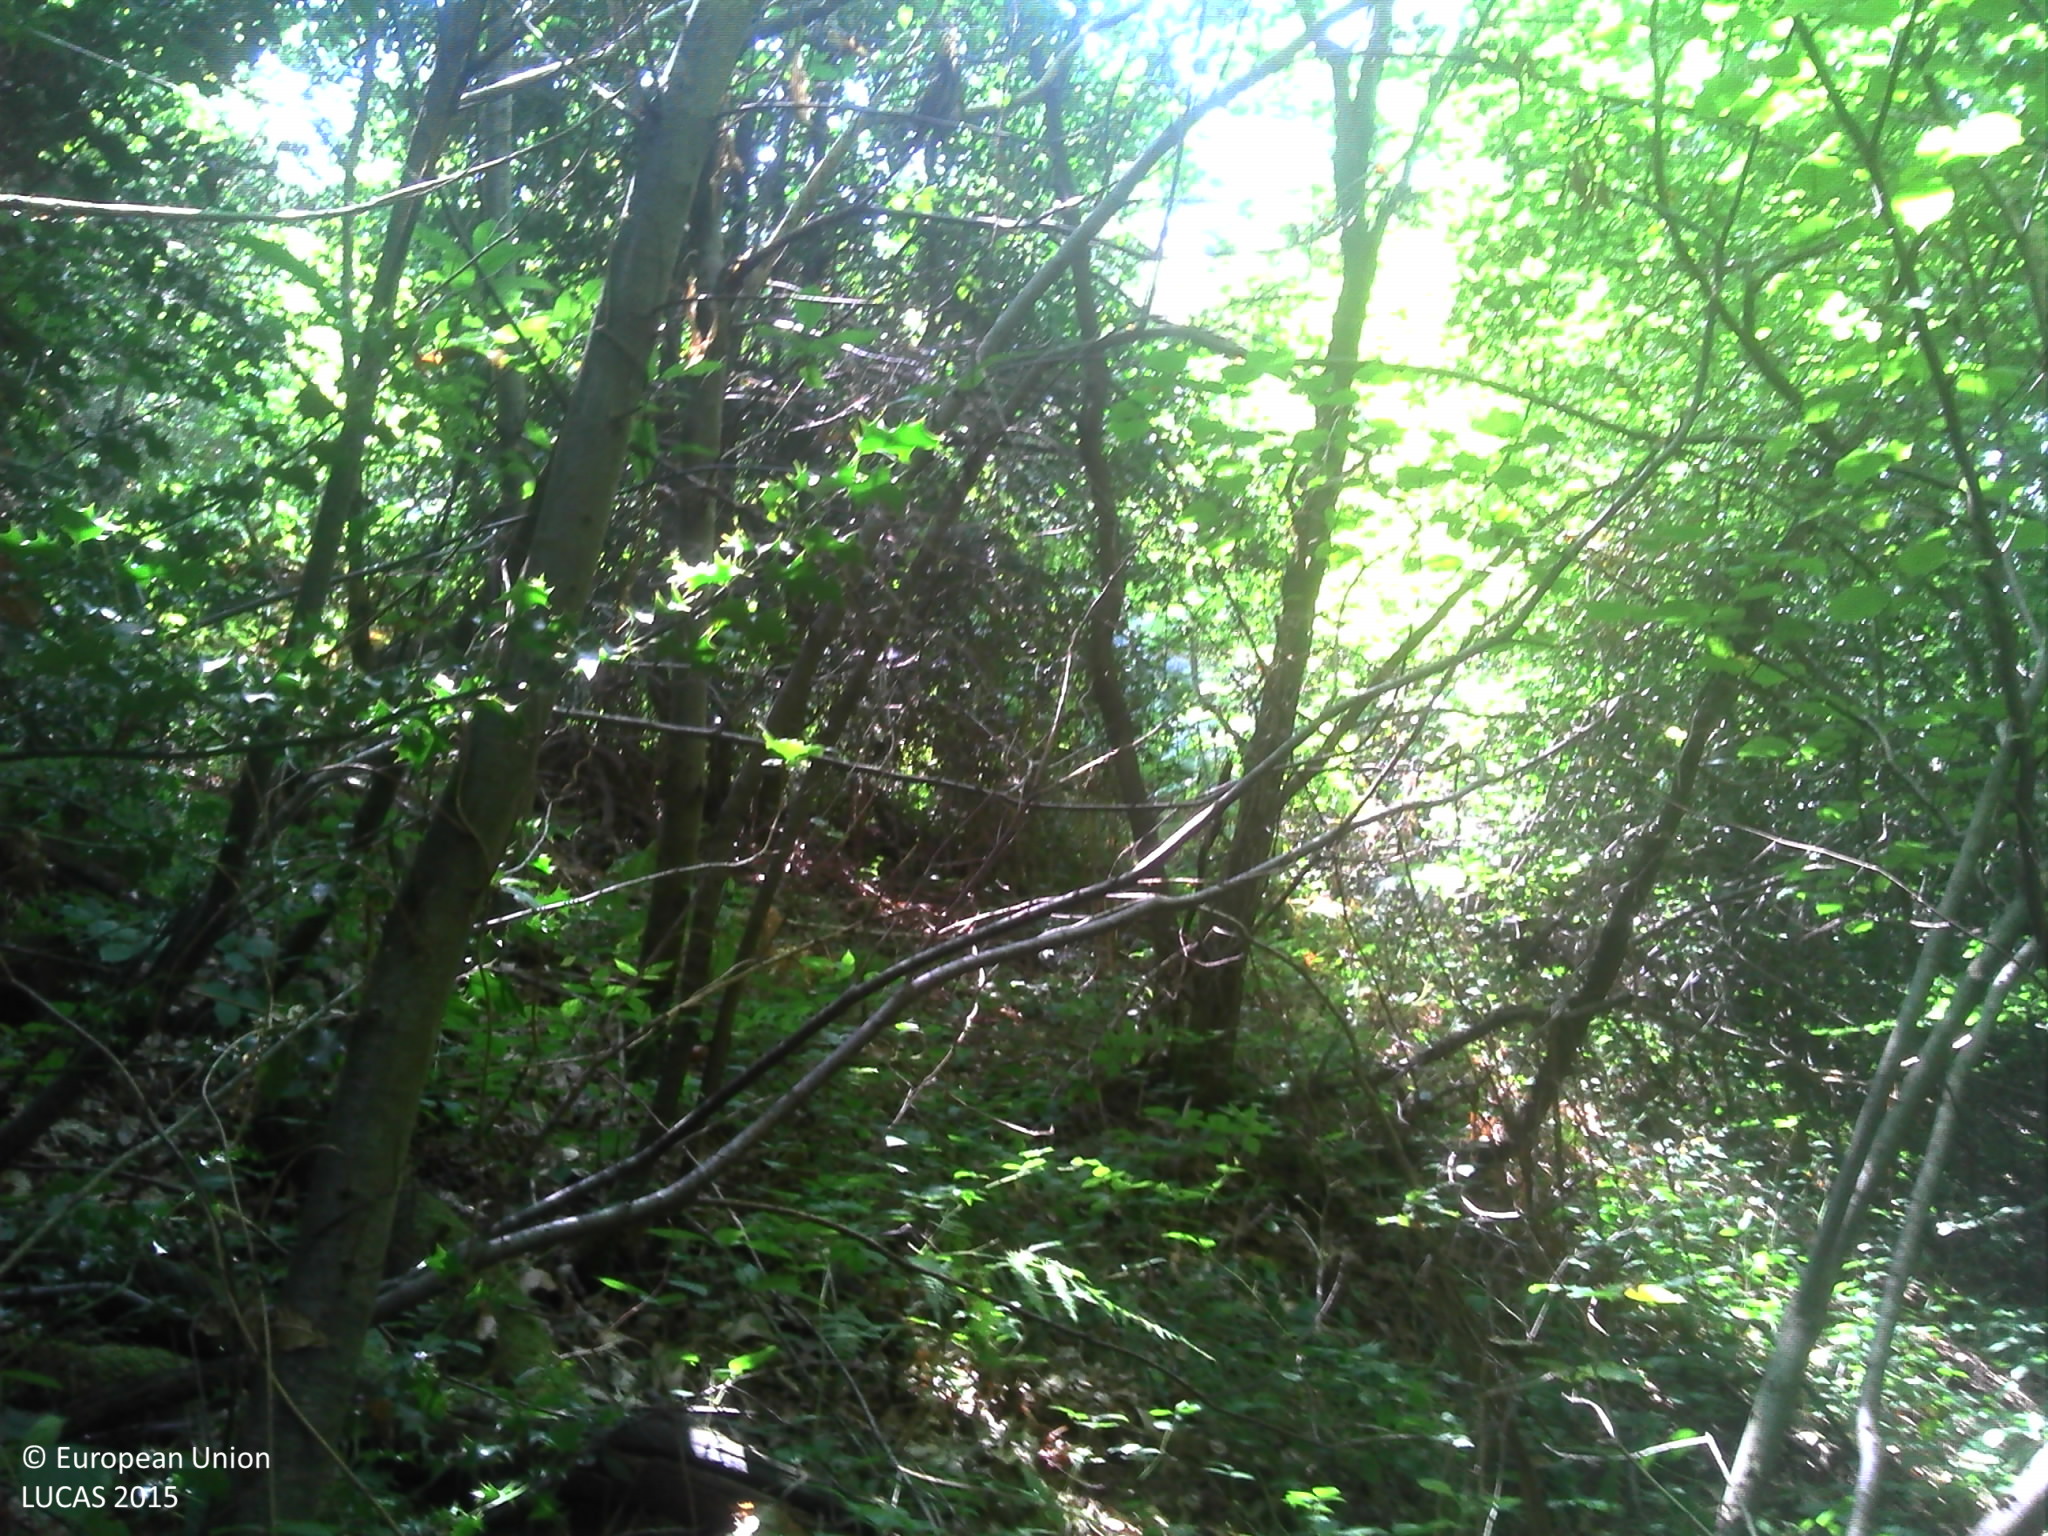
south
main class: Woodland
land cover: Broadleaved woodland
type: floodplain forest
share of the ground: > 75 %
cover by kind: broadleaved forest trees 95 %, coniferous forest trees 5 %
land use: Forestry
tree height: > 5 m
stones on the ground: 10 - 25 %
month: September
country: FR
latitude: 45.2318
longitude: 5.1777
